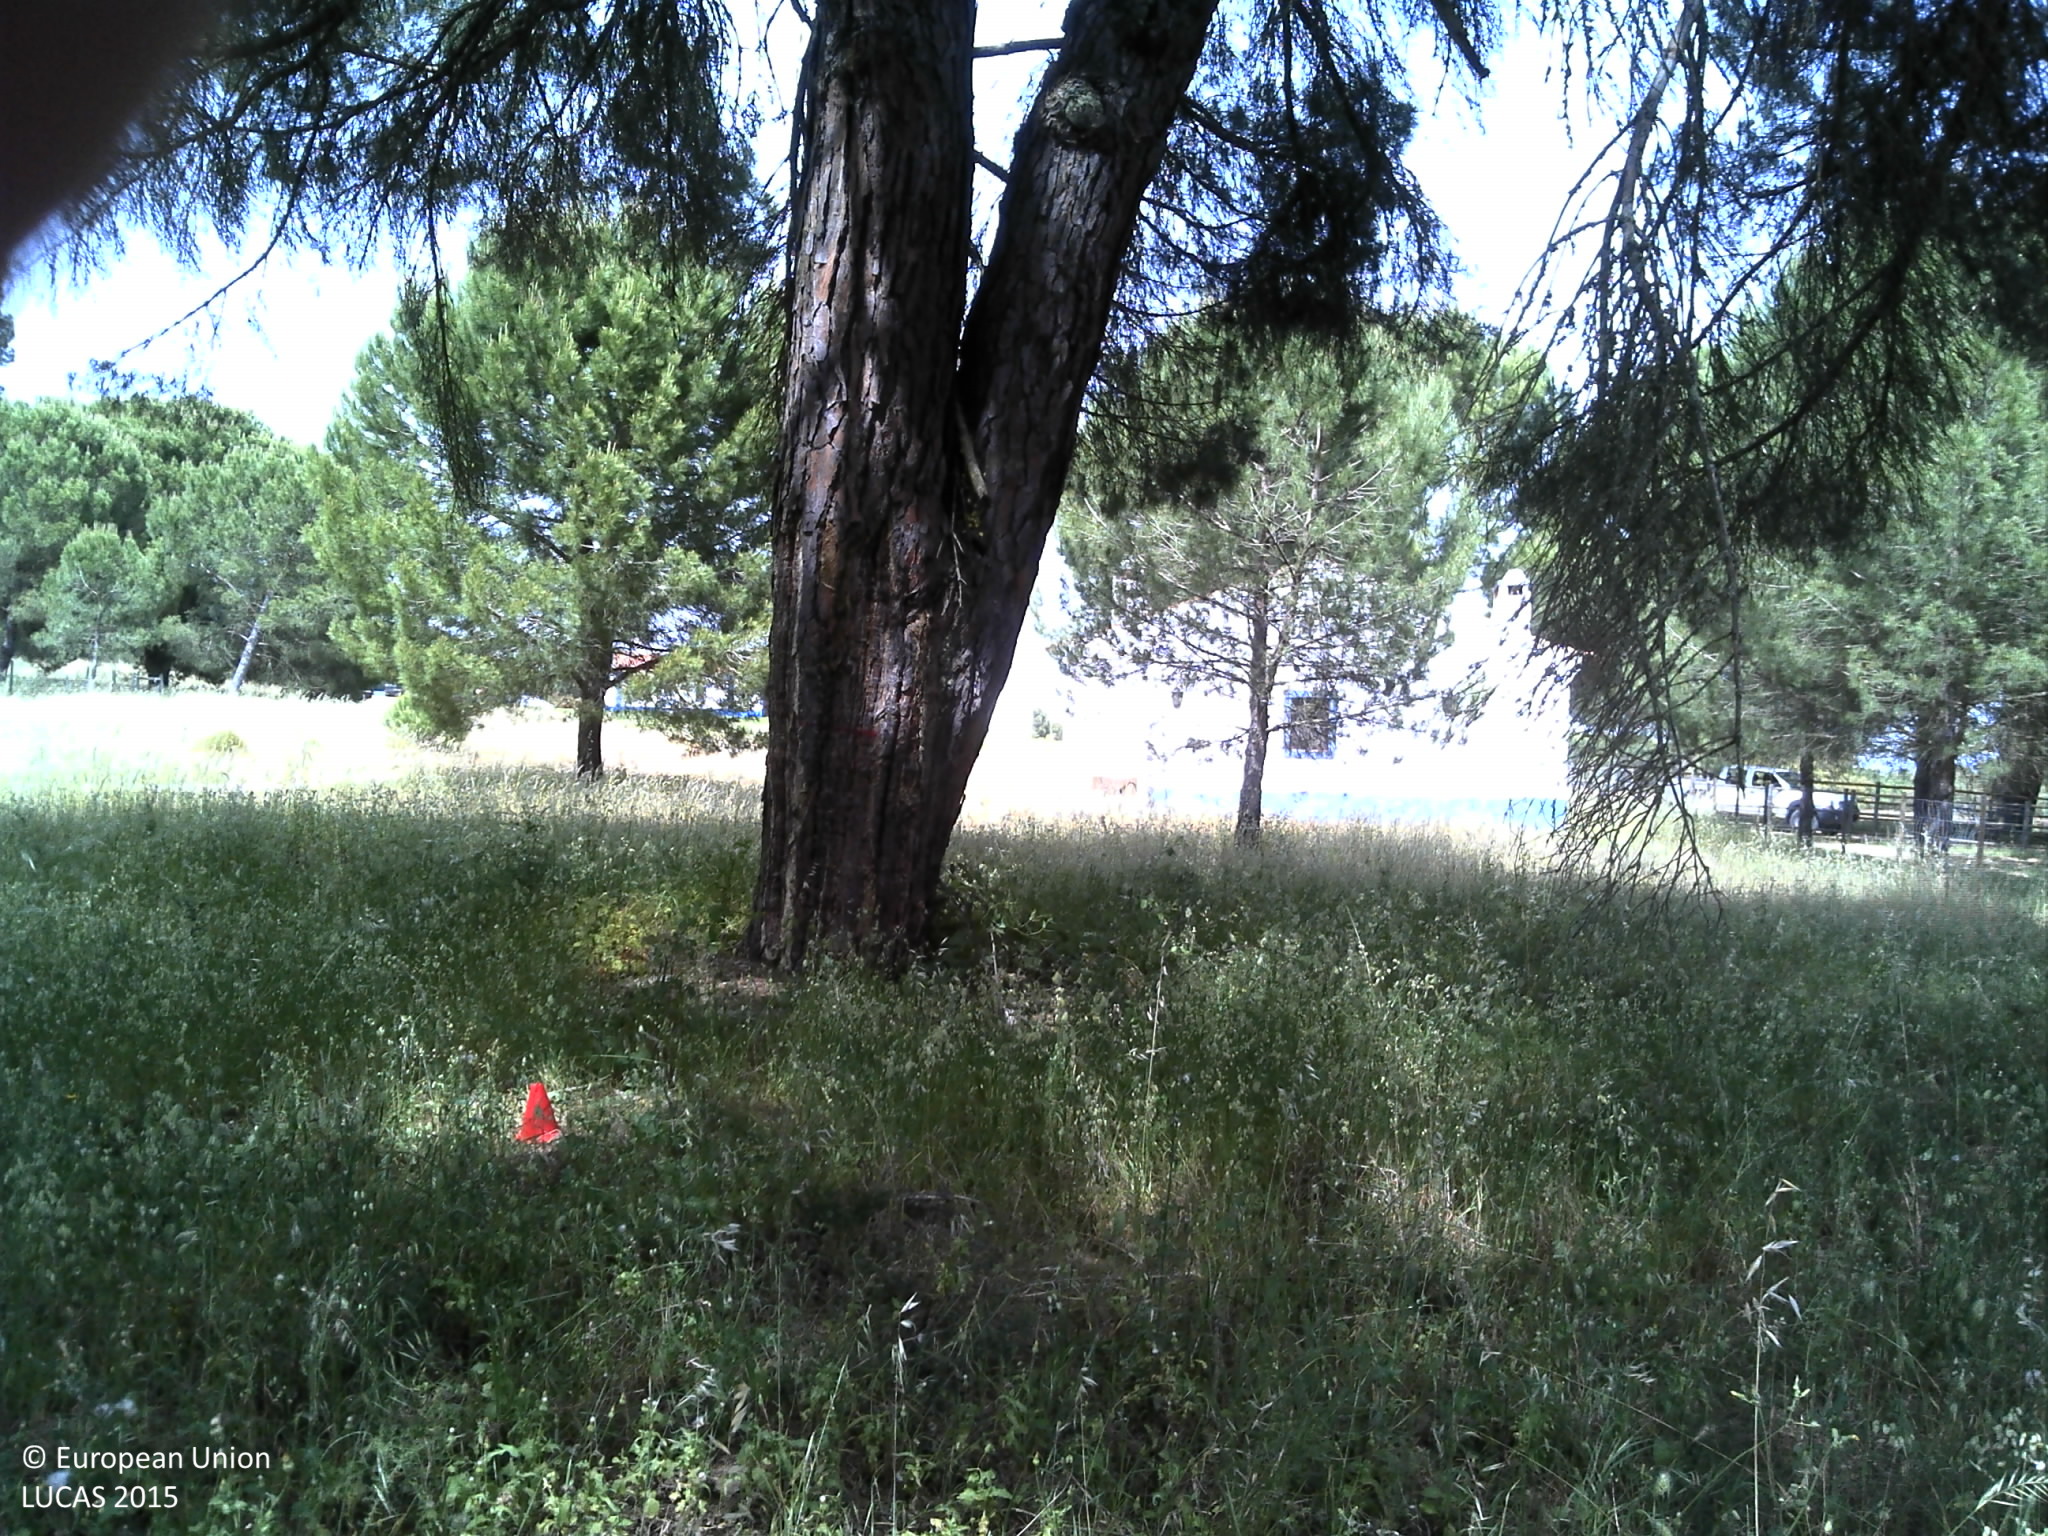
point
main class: Woodland
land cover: Pine dominated coniferous woodland
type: coniferous forest of the mediterranean region
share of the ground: > 75 %
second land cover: Spontaneously vegetated surfaces
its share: > 75 %
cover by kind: coniferous forest trees 75 %, herbaceous plants 25 %
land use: Forestry
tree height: > 5 m
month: May
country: PT
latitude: 38.3853
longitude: -8.4702
